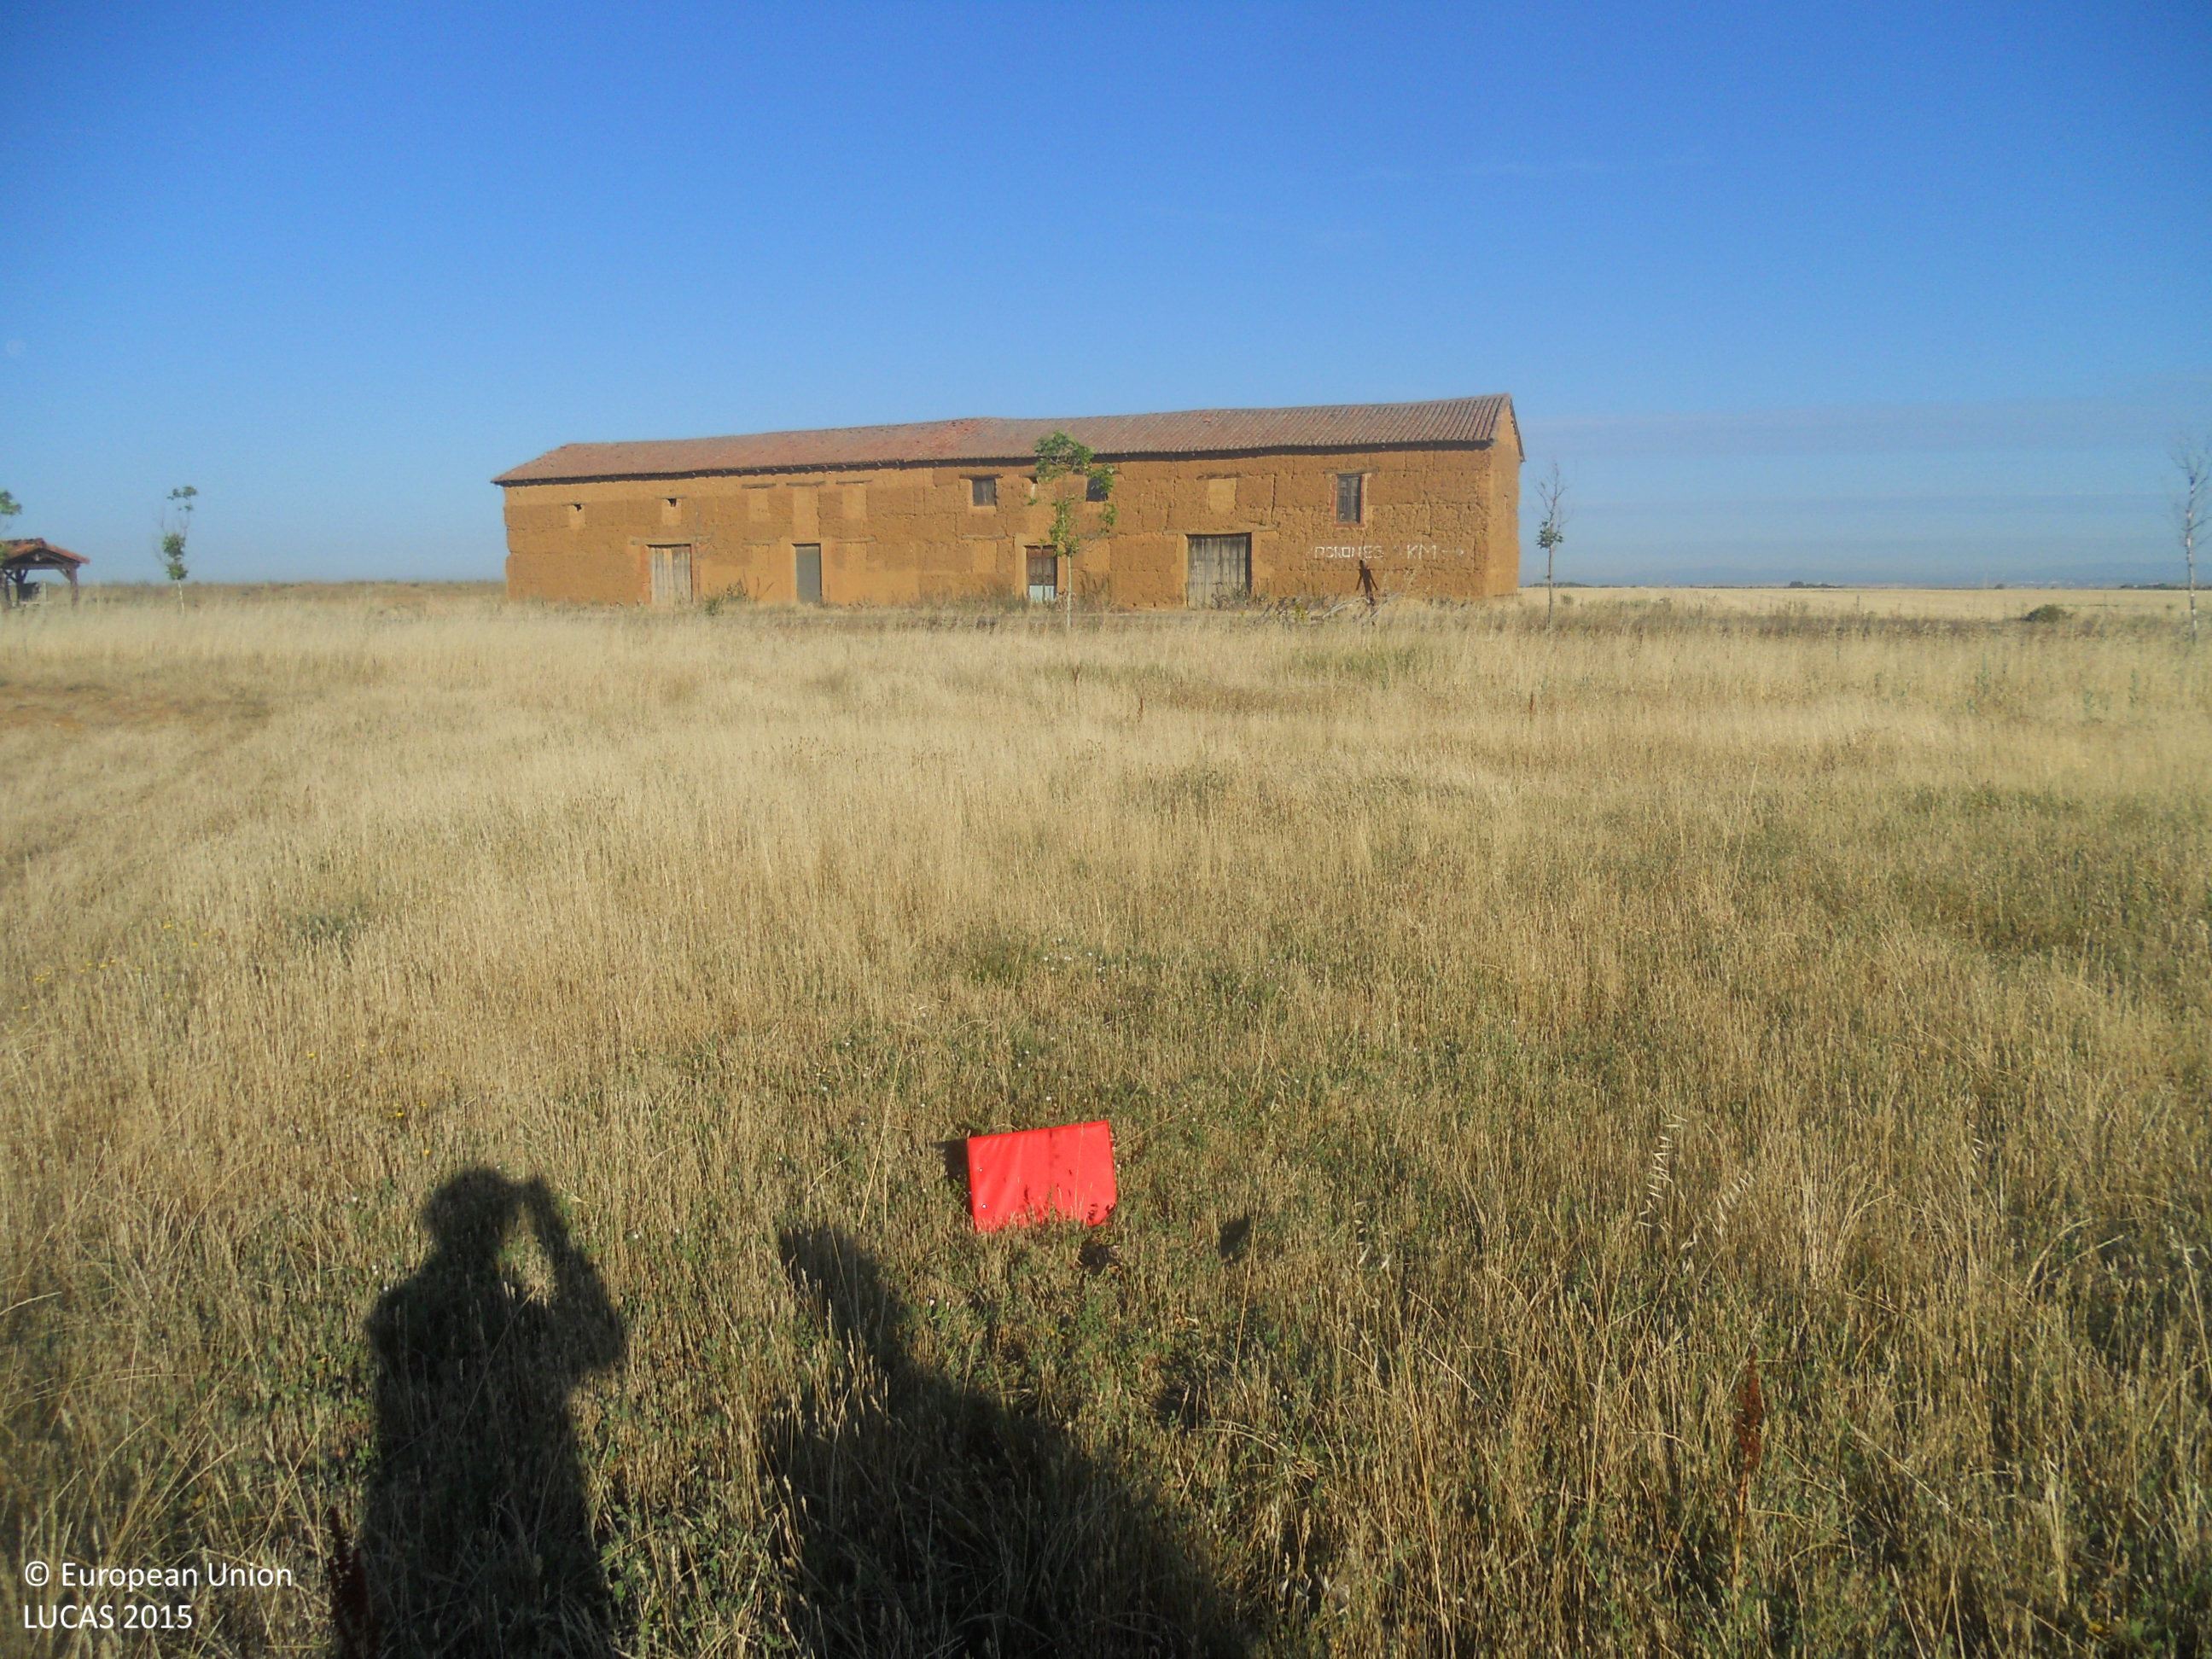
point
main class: Grassland
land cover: Grassland without tree/shrub cover
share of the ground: > 75 %
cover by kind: herbaceous plants 100 %
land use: Abandoned areas
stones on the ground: > 50 %
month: July
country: ES
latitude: 42.4557
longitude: -5.3020
